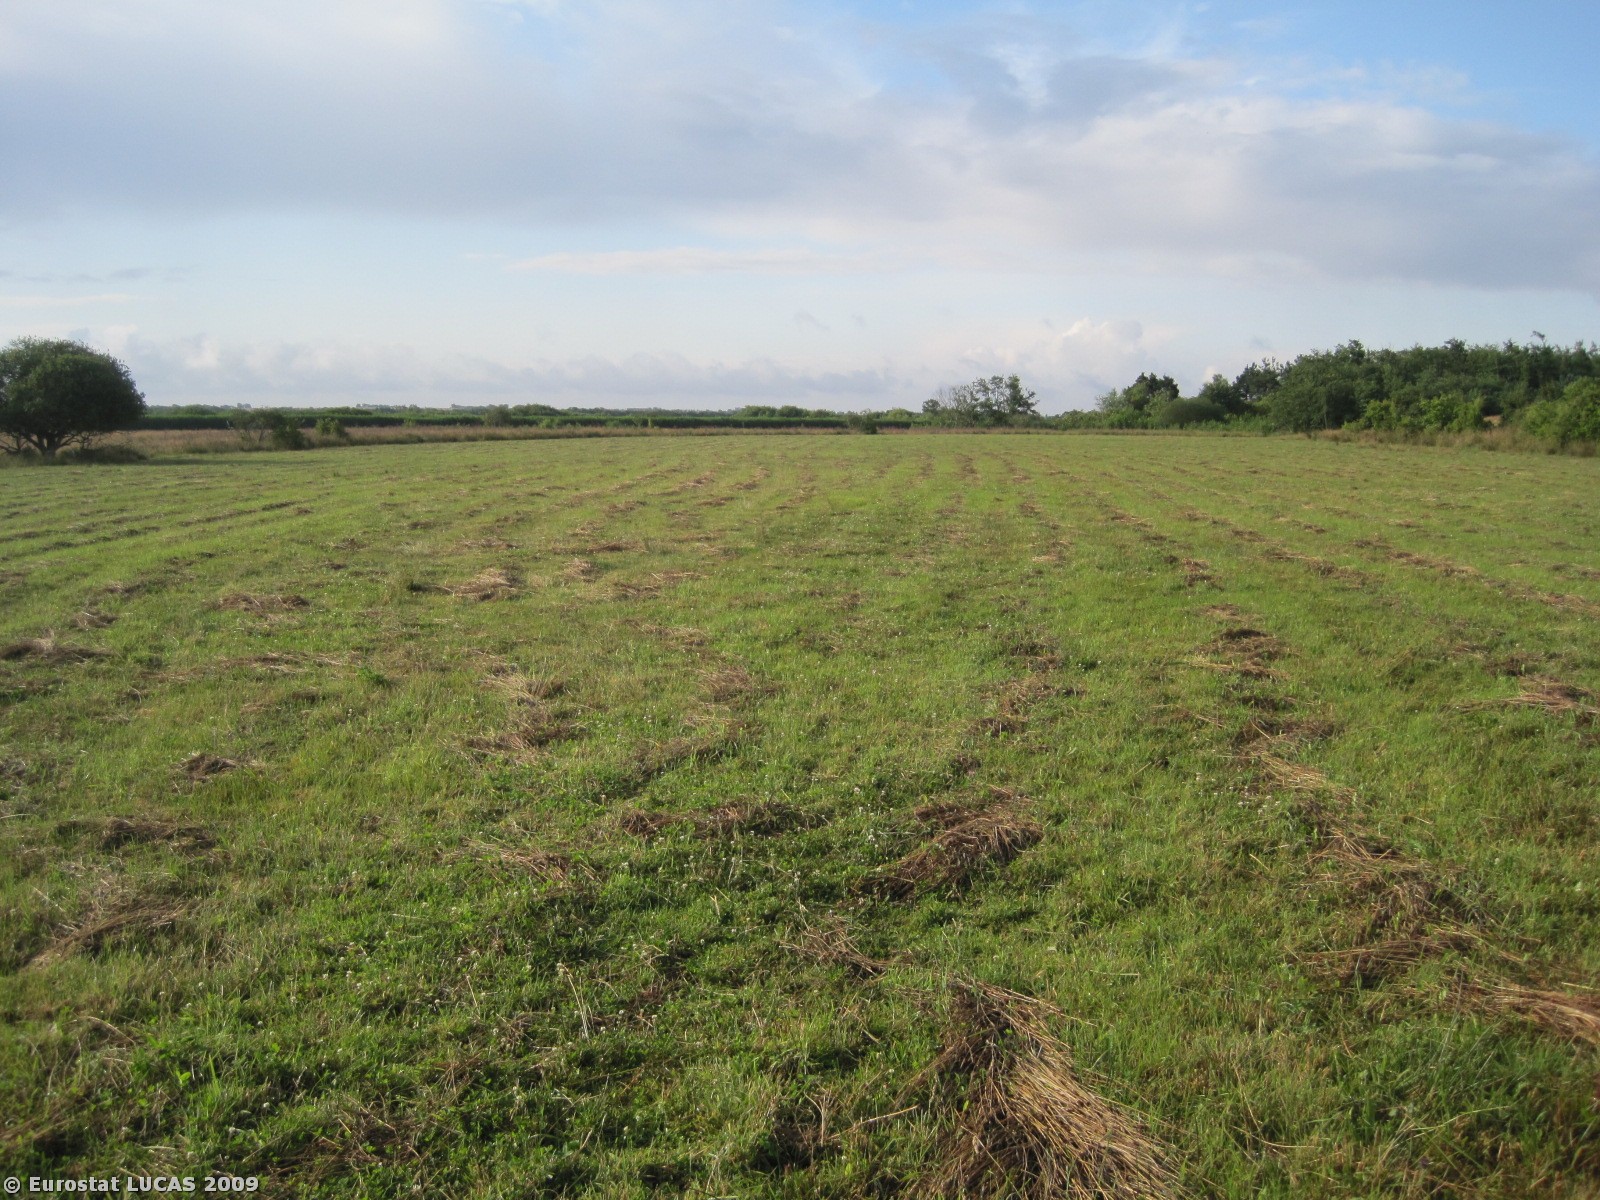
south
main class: Grassland
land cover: Grassland without tree/shrub cover
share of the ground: > 75 %
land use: Agriculture (excluding fallow land and kitchen gardens)
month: July
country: DK
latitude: 57.0463
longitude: 8.9302
